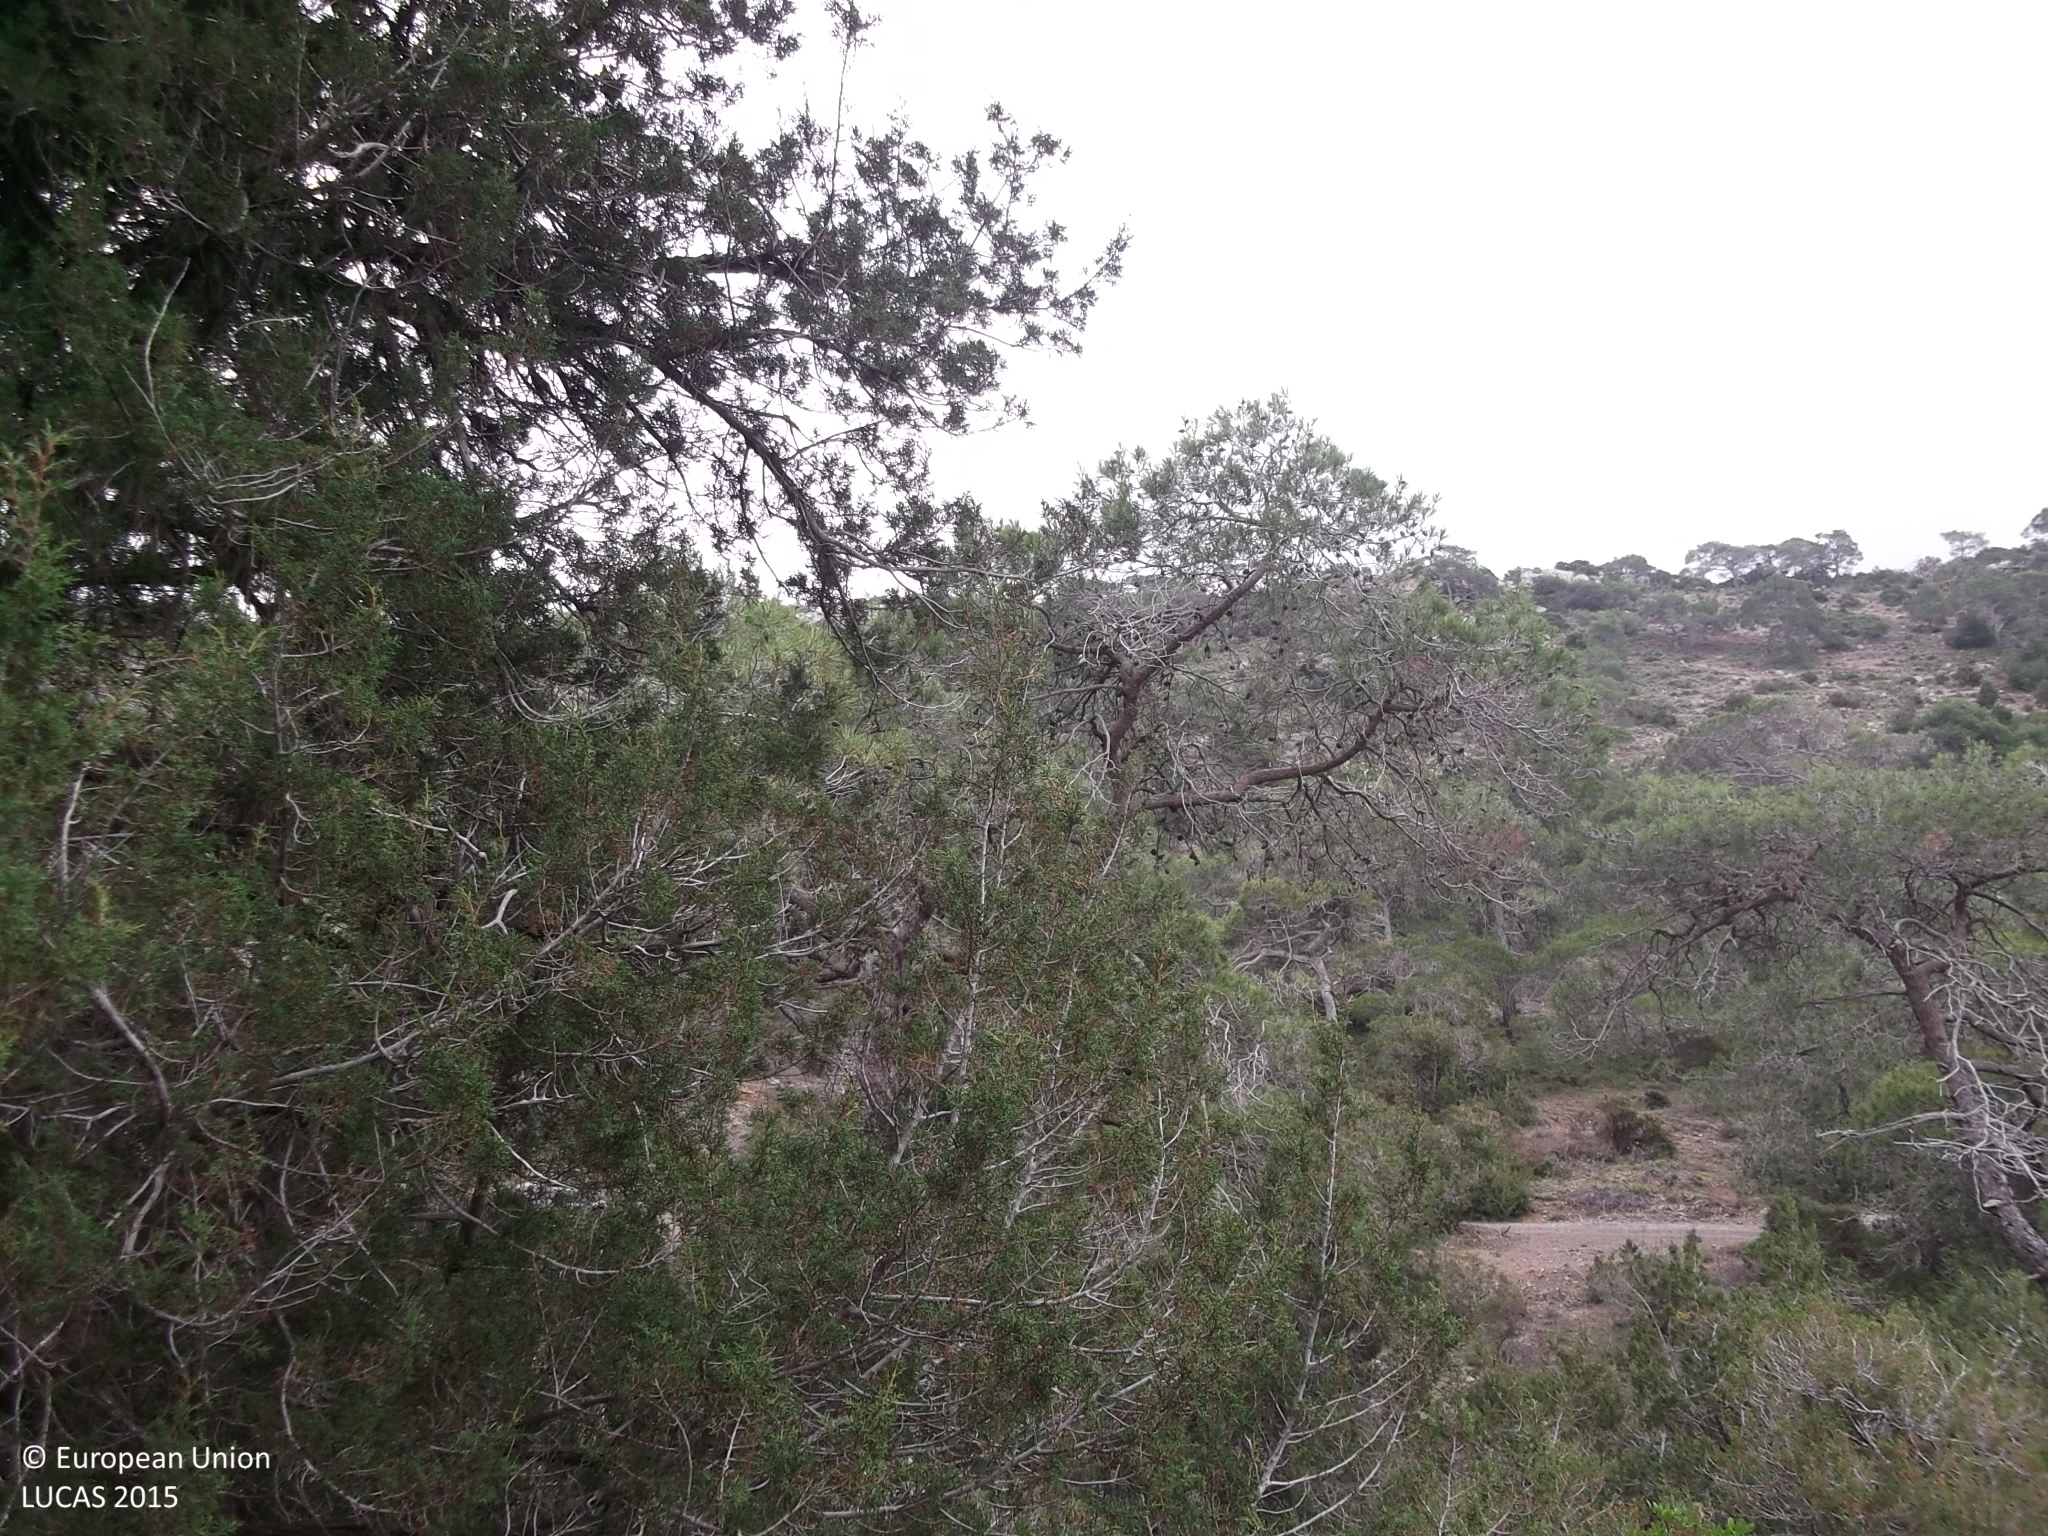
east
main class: Woodland
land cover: Other coniferous woodland
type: coniferous forest of the mediterranean region
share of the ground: > 75 %
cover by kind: coniferous forest trees 80 %, shrubs 10 %, unconsolidated bare surface 10 %
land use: Forestry
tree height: > 5 m
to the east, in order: Other coniferous woodland; Tracks; Other coniferous woodland; Tracks
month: May
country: CY
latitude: 35.0385
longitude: 32.3257
